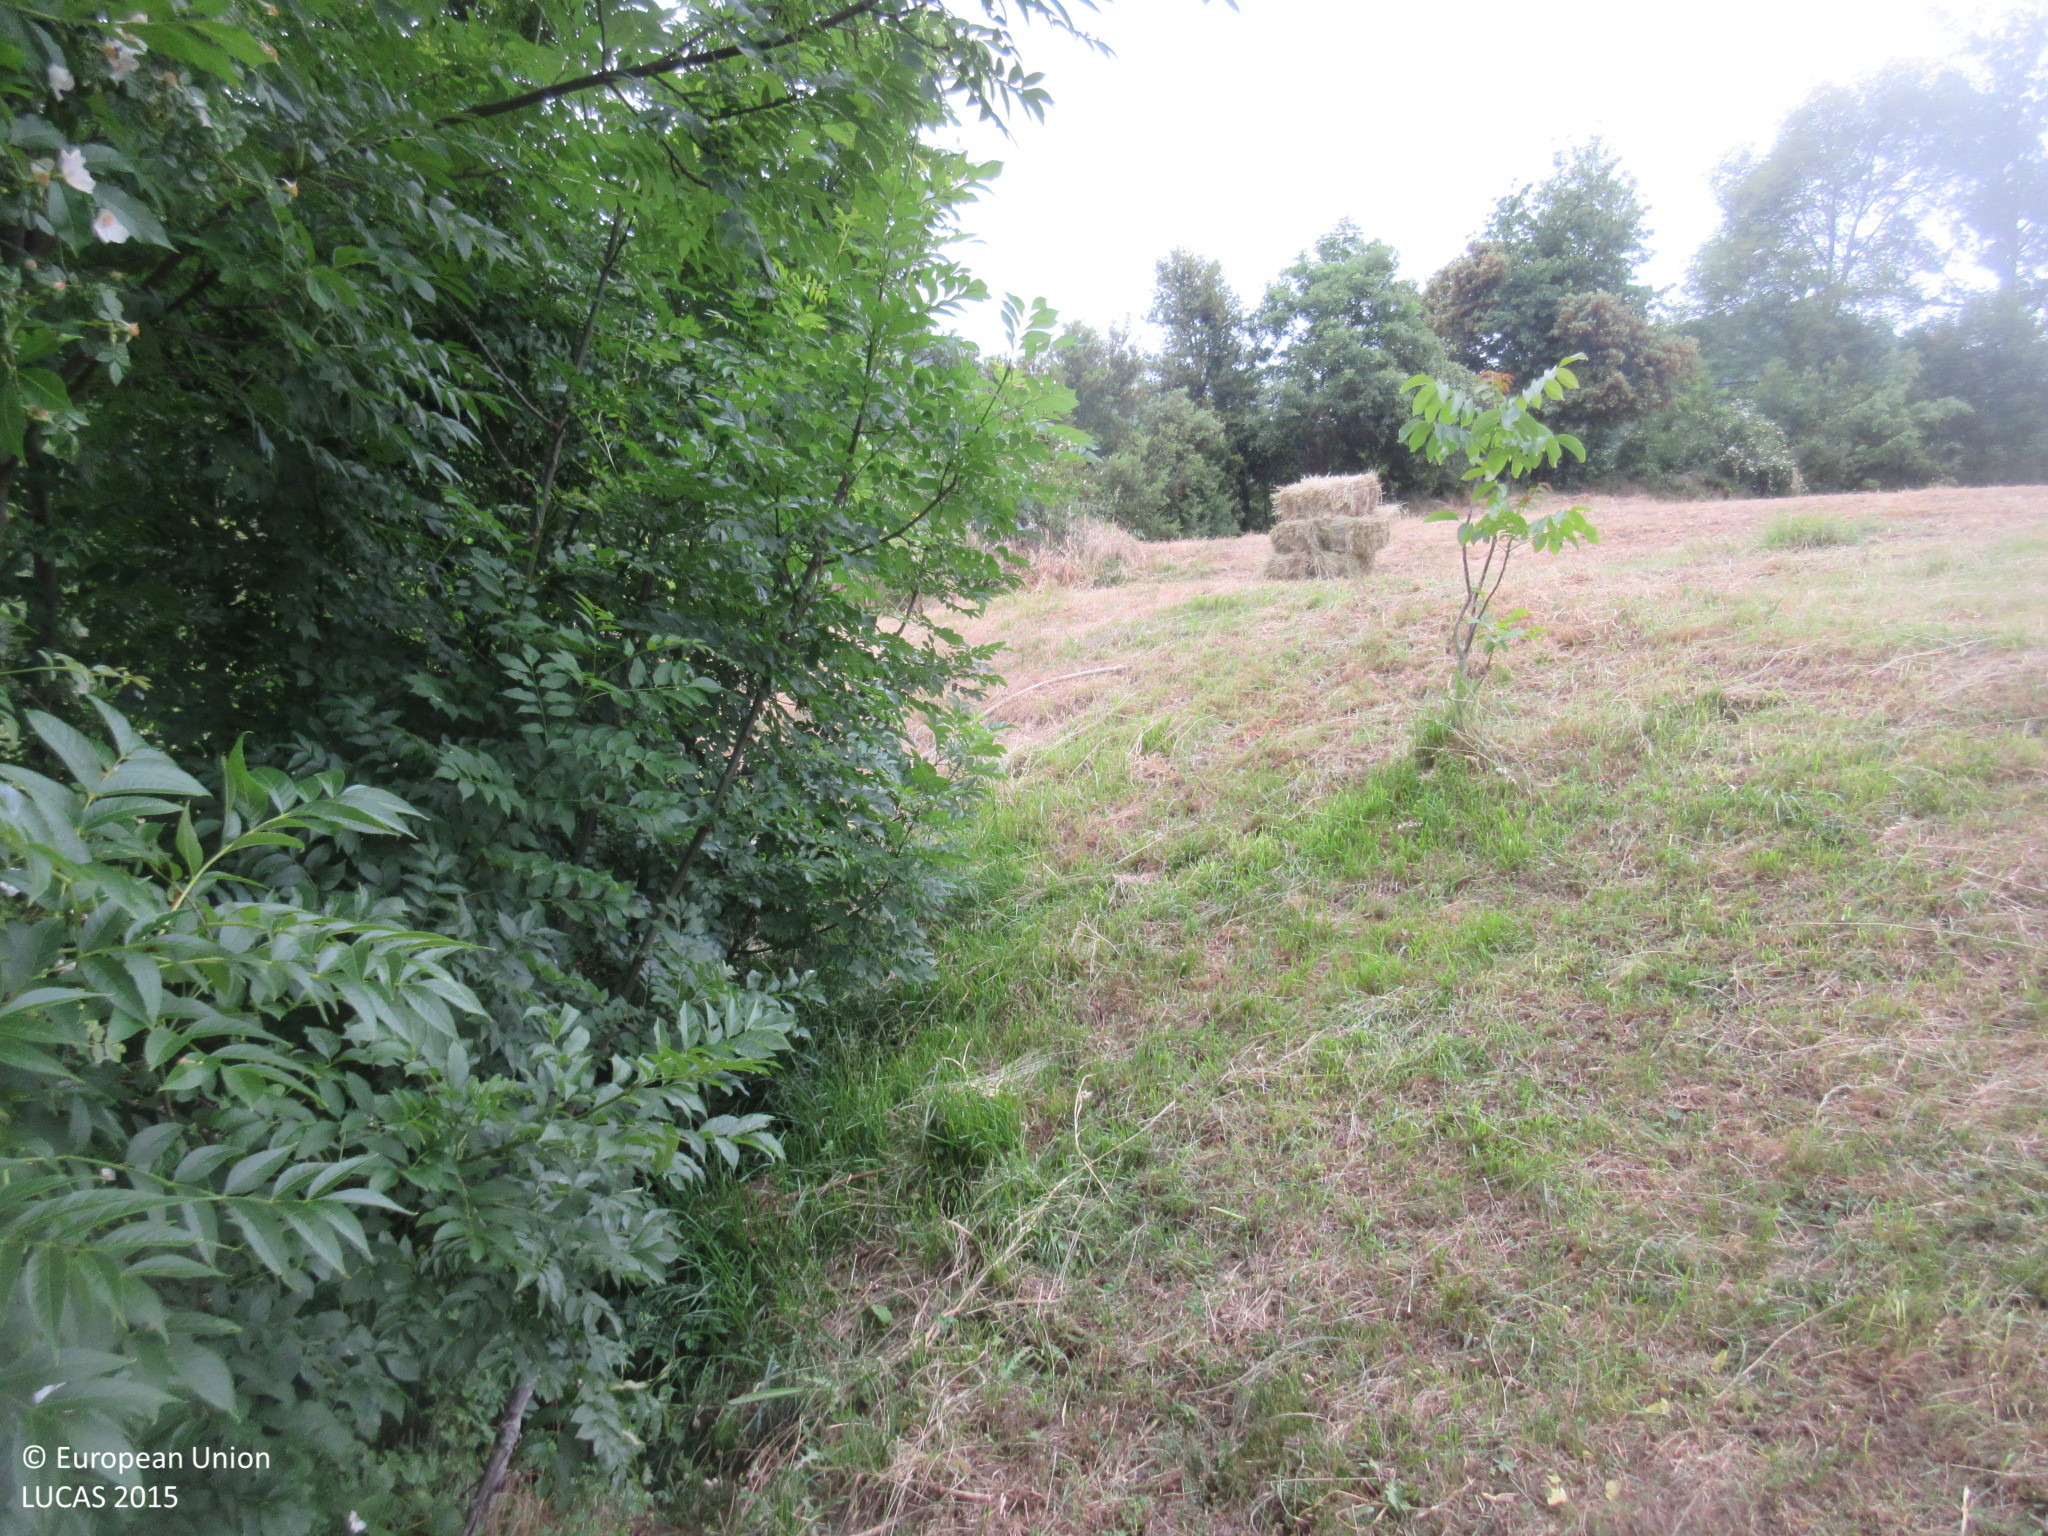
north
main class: Woodland
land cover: Broadleaved woodland
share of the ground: > 75 %
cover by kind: broadleaved forest trees 75 %, shrubs 25 %
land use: Semi-natural and natural areas not in use
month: June
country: ES
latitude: 43.1527
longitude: -4.5576
